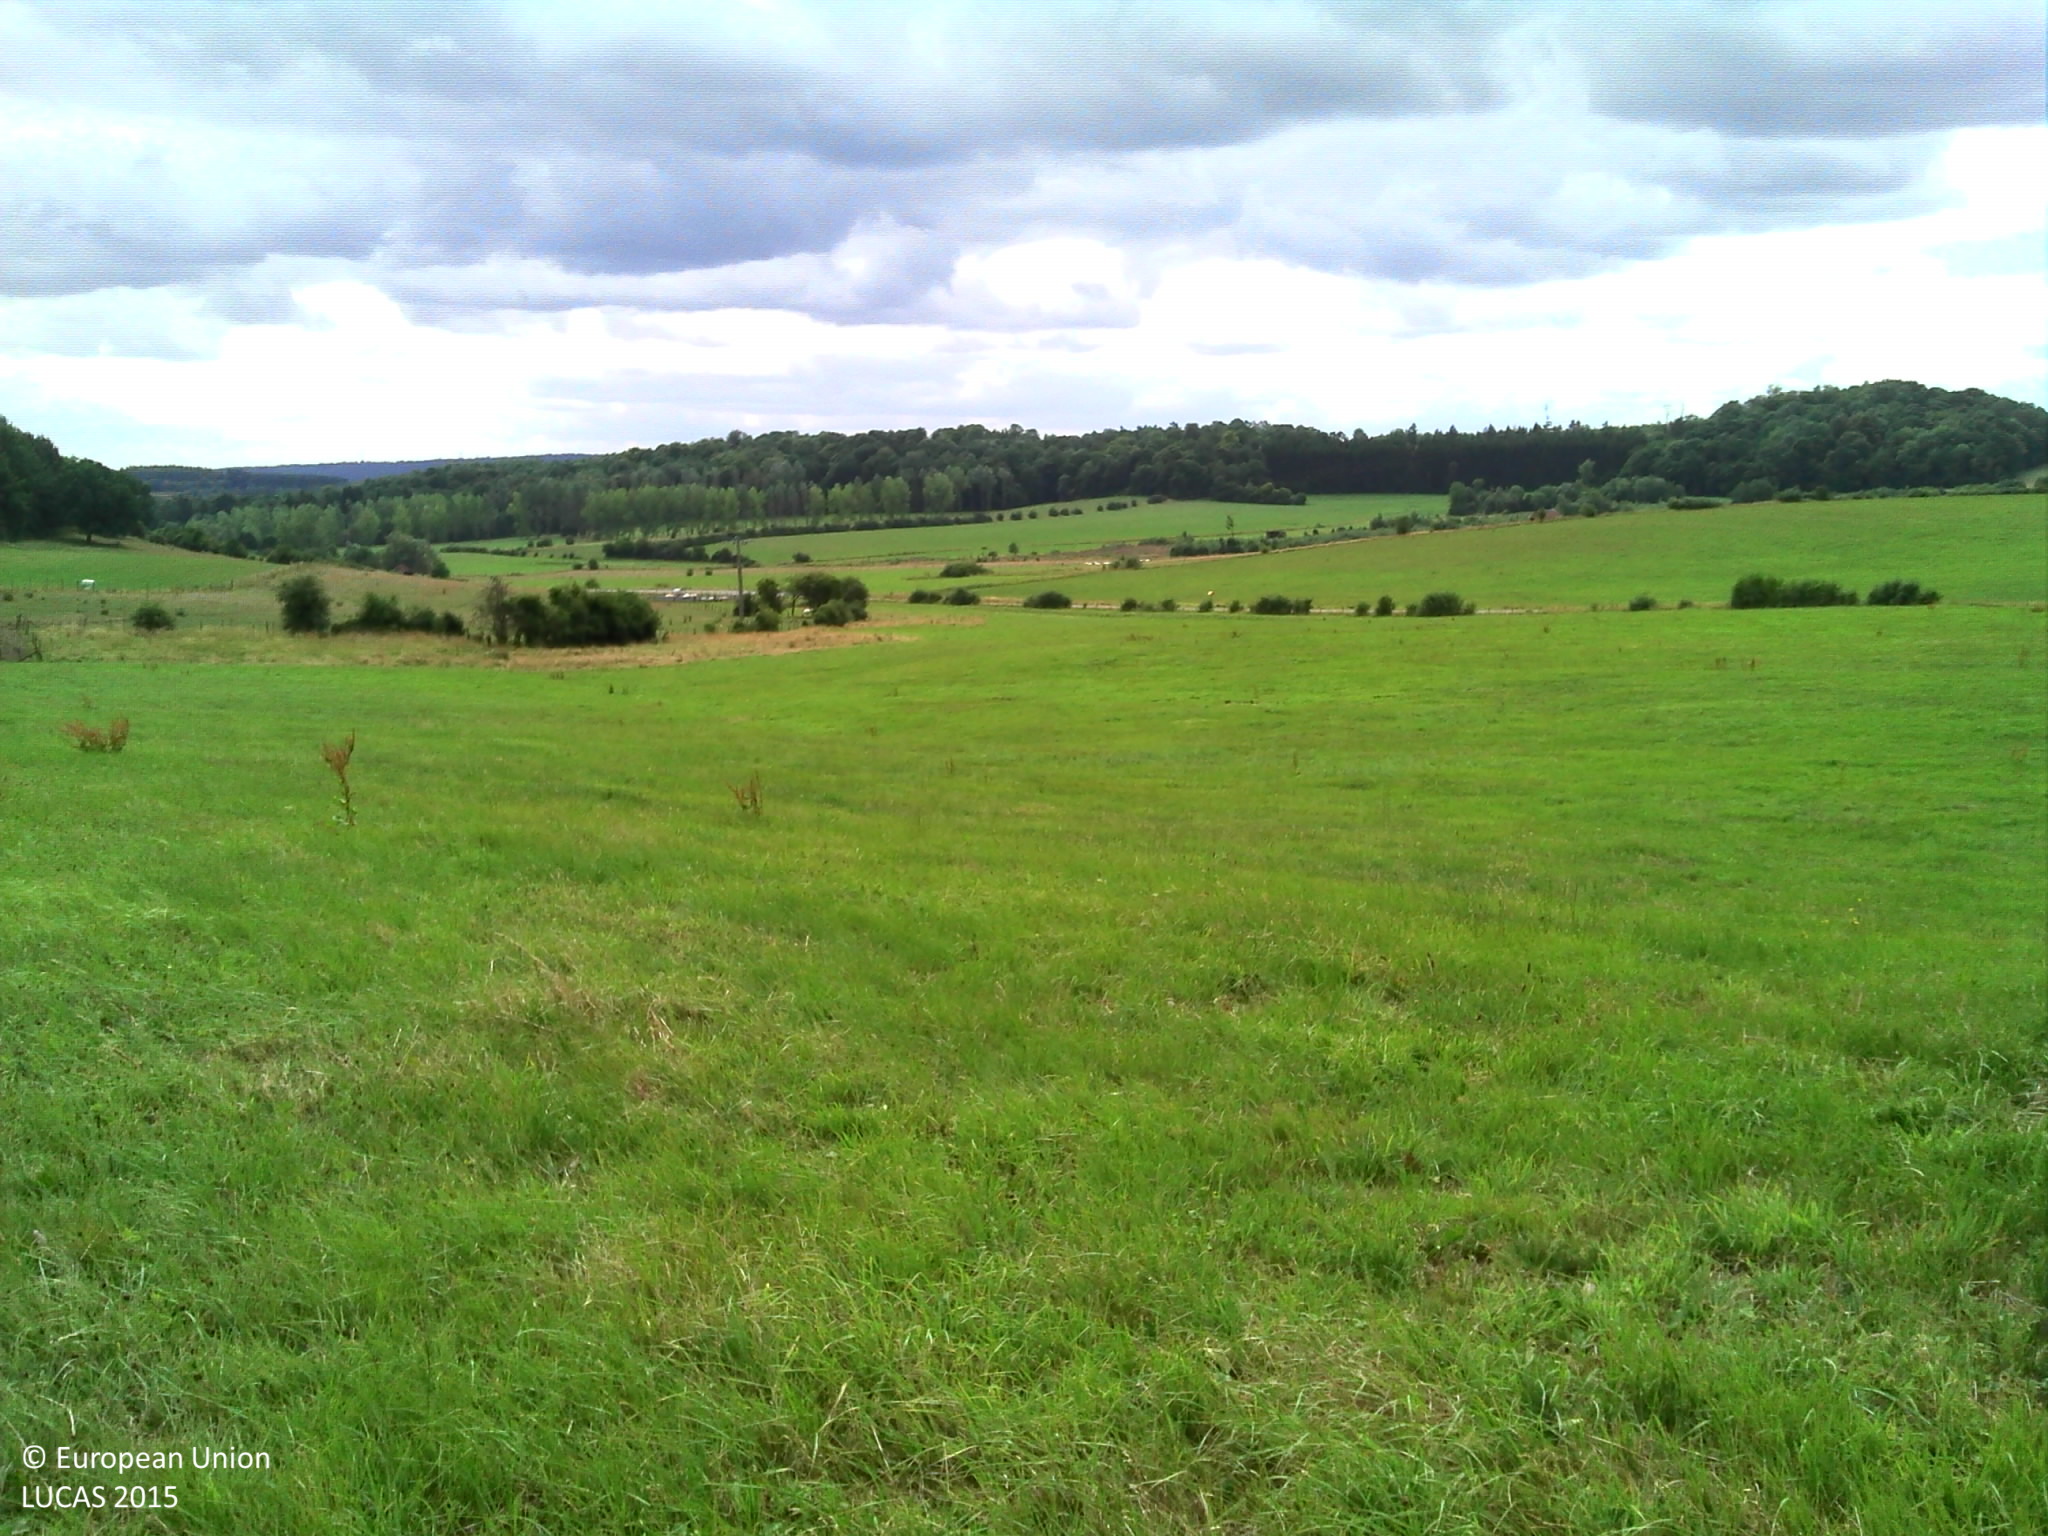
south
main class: Grassland
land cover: Grassland without tree/shrub cover
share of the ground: > 75 %
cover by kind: herbaceous plants 100 %
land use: Agriculture (excluding fallow land and kitchen gardens)
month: July
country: BE
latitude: 49.5977
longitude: 5.6682
